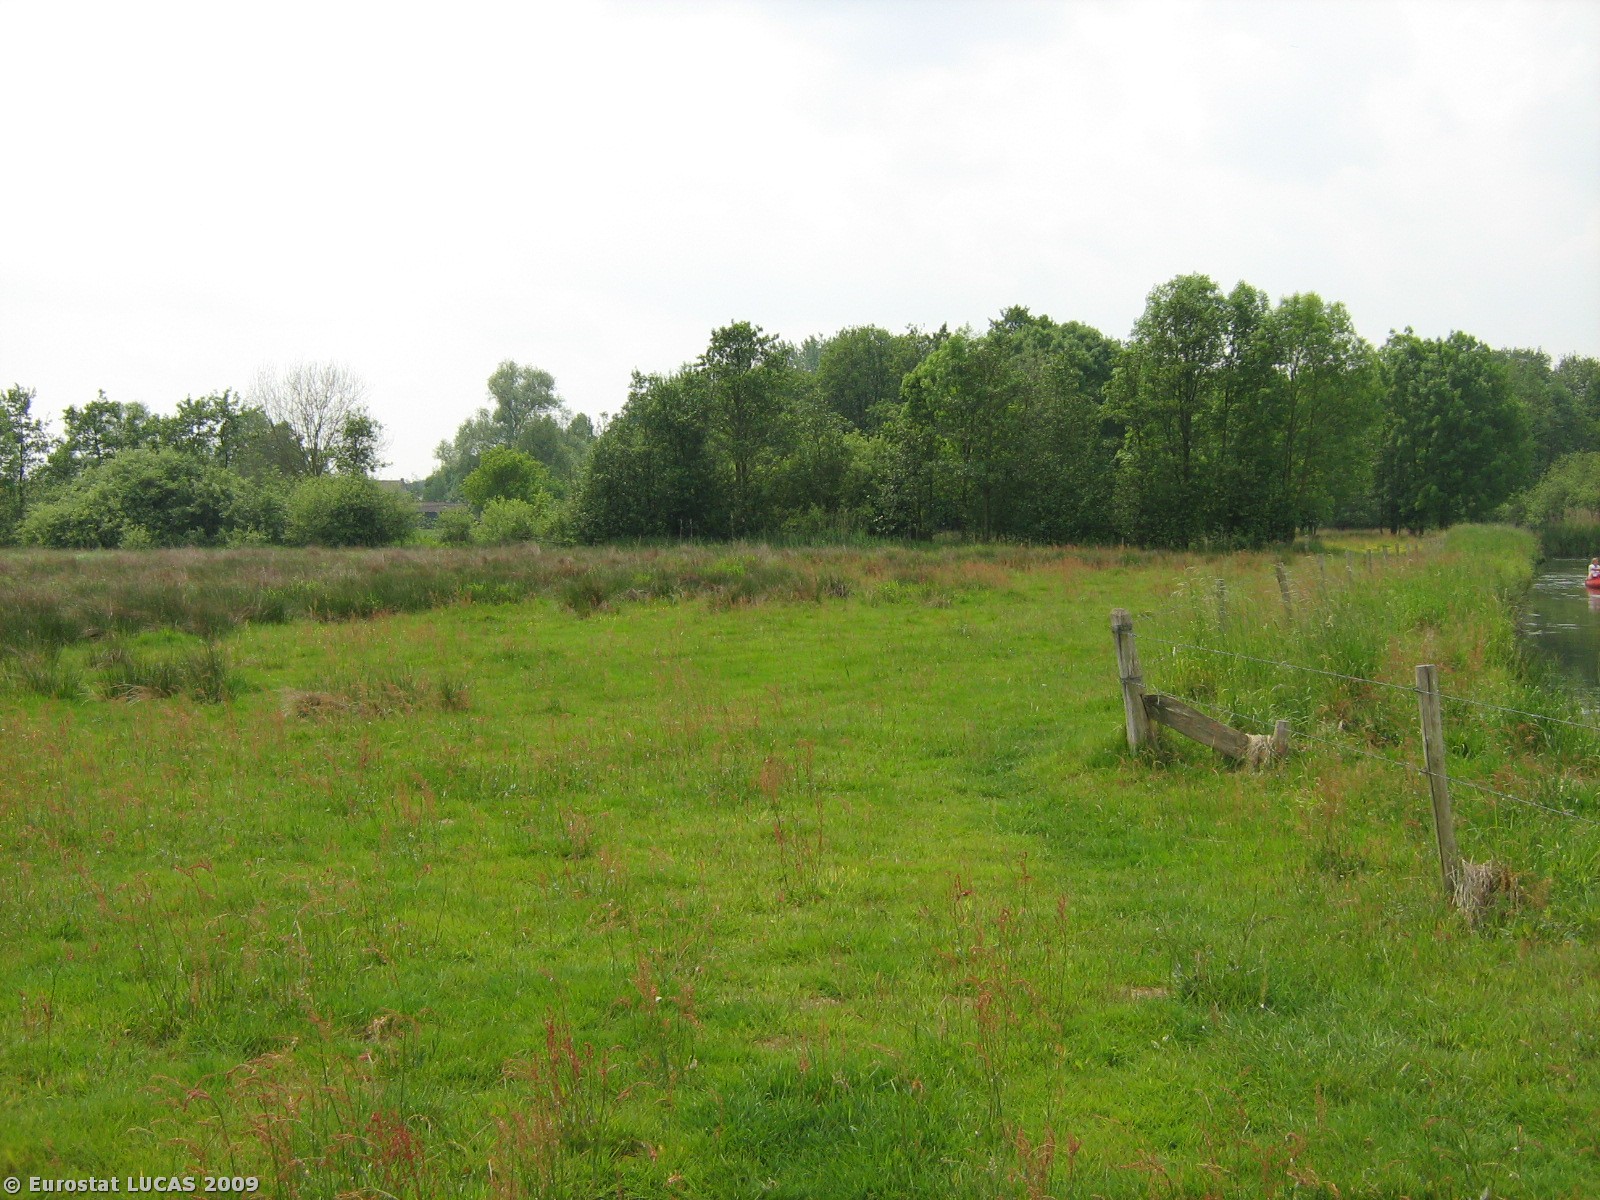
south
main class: Grassland
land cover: Grassland without tree/shrub cover
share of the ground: > 75 %
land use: Nature reserves
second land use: Agriculture (excluding fallow land and kitchen gardens)
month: May
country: NL
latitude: 51.3001
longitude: 5.4514
